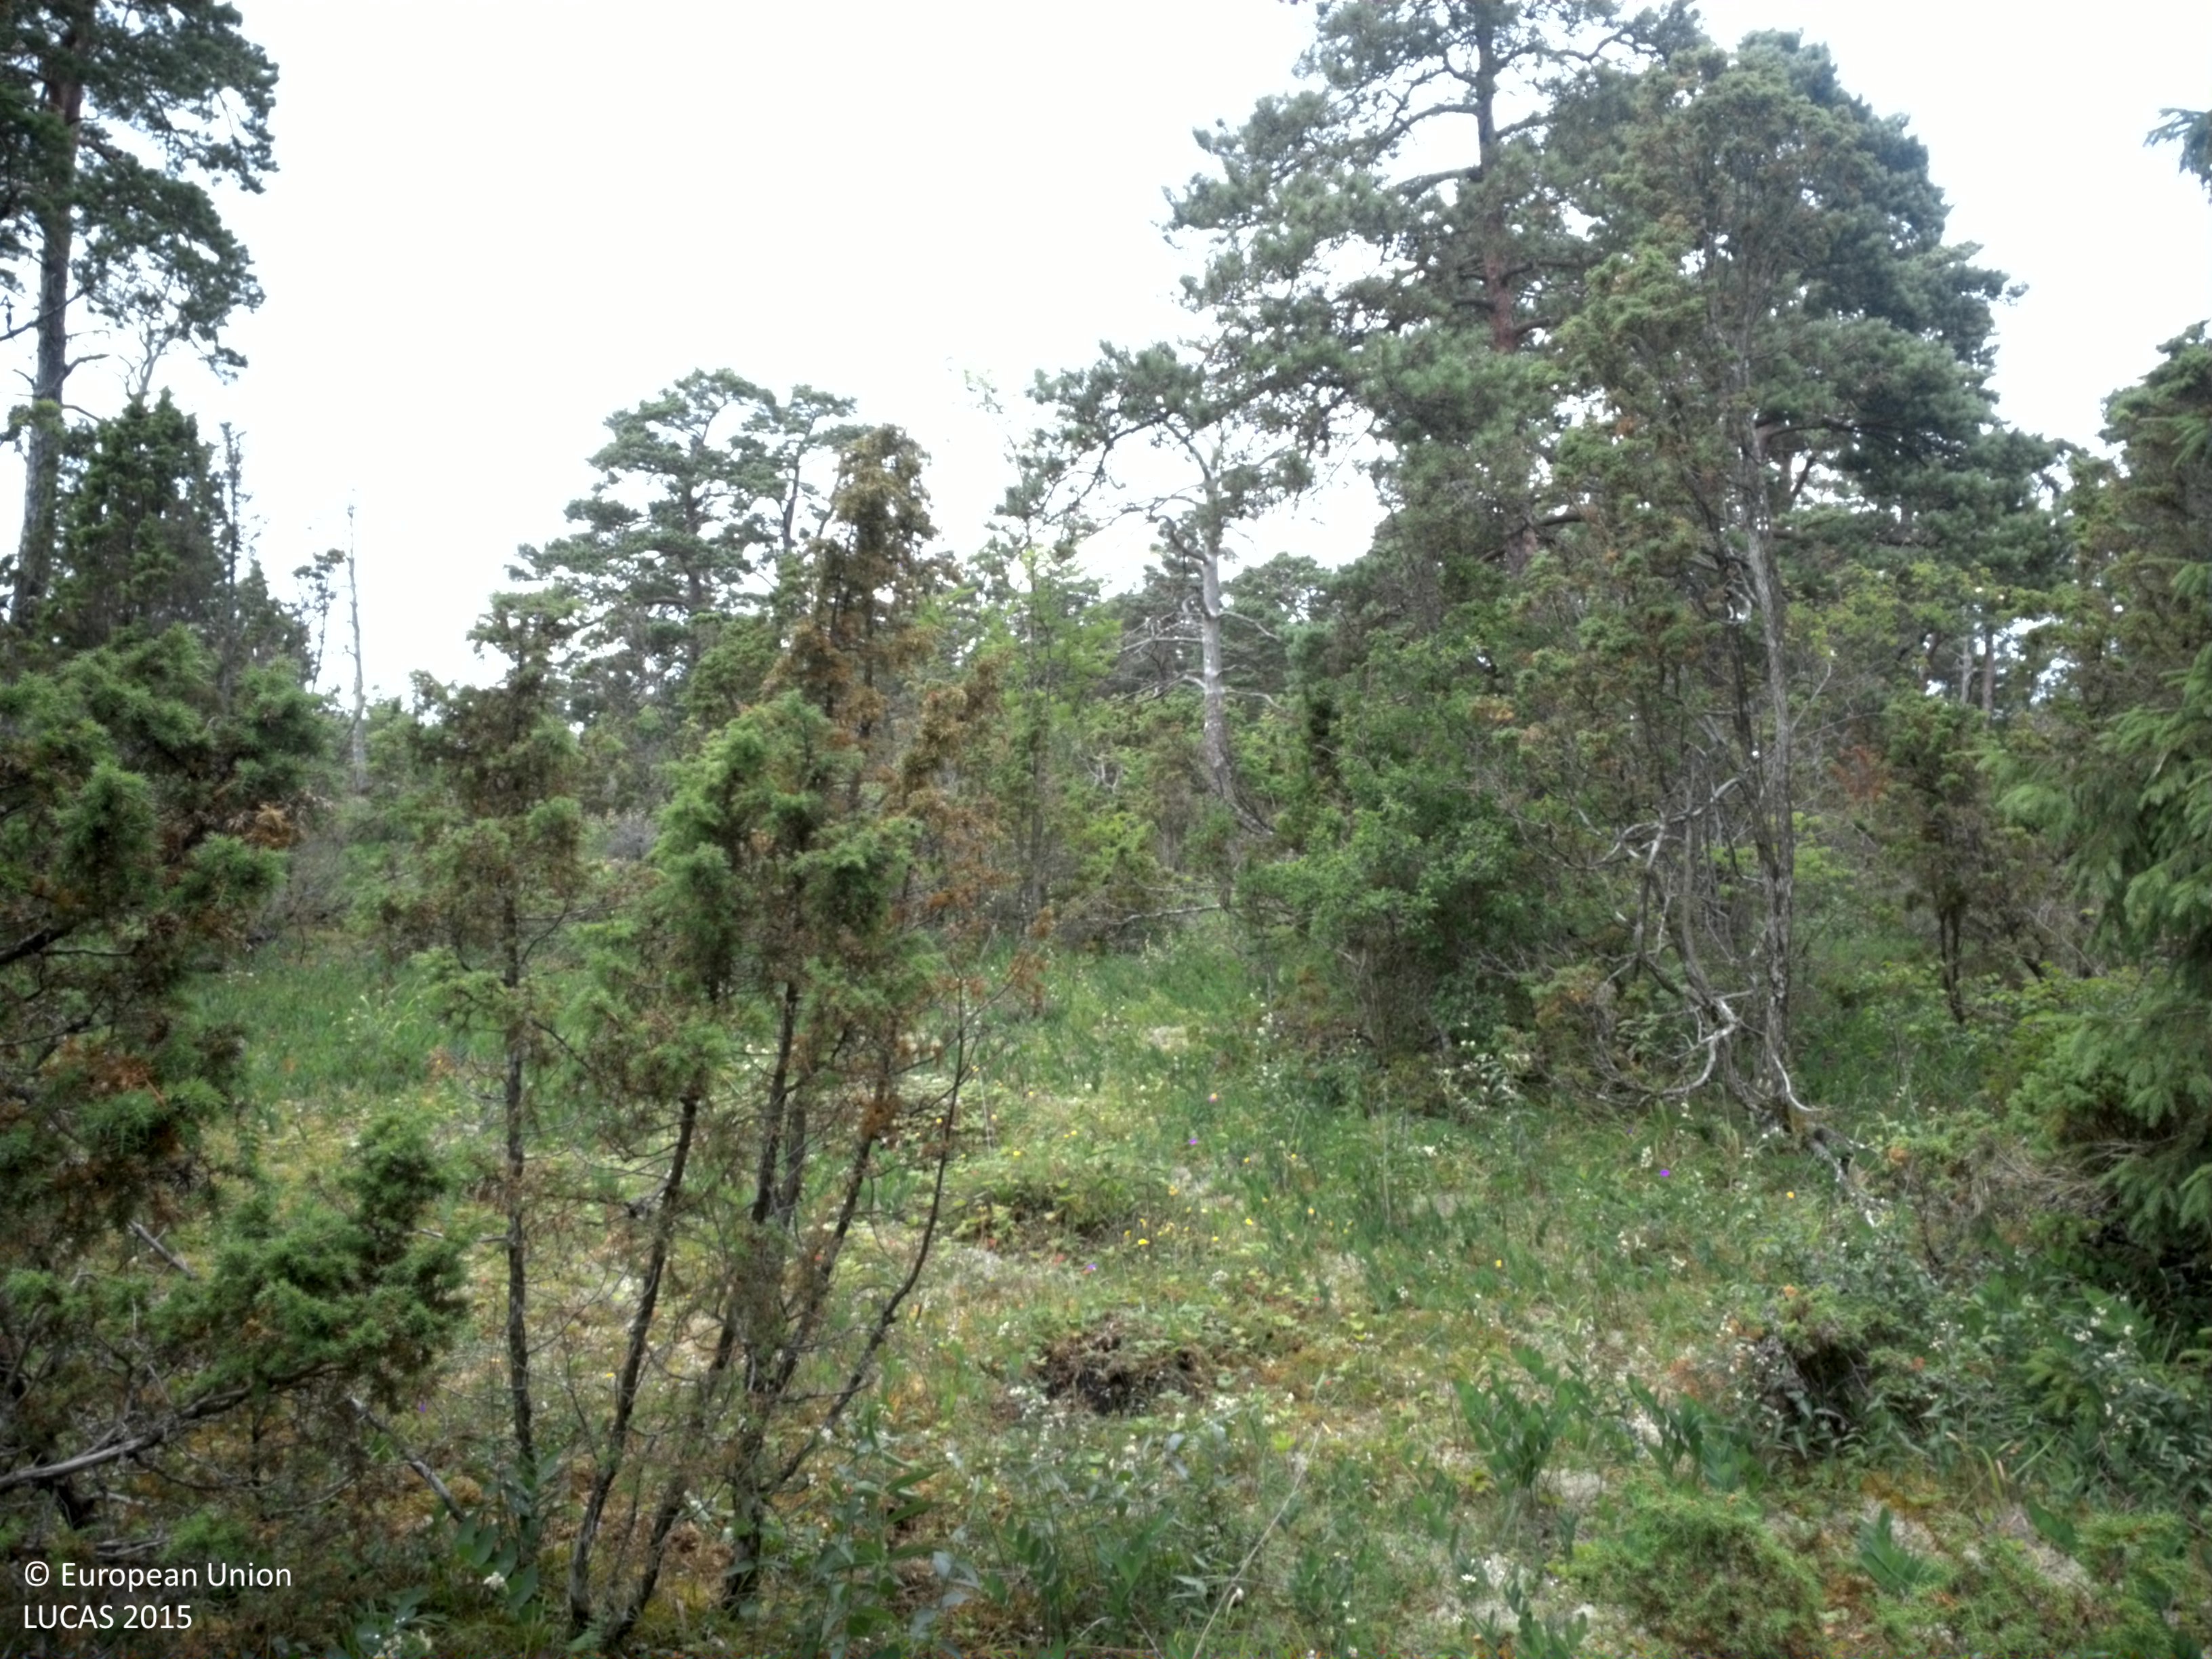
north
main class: Shrubland
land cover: Shrubland with sparse tree cover
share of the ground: > 75 %
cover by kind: shrubs 75 %, herbaceous plants 15 %, coniferous forest trees 5 %, lichens and mosses 5 %
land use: Semi-natural and natural areas not in use
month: July
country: SE
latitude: 57.4245
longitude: 18.7869
